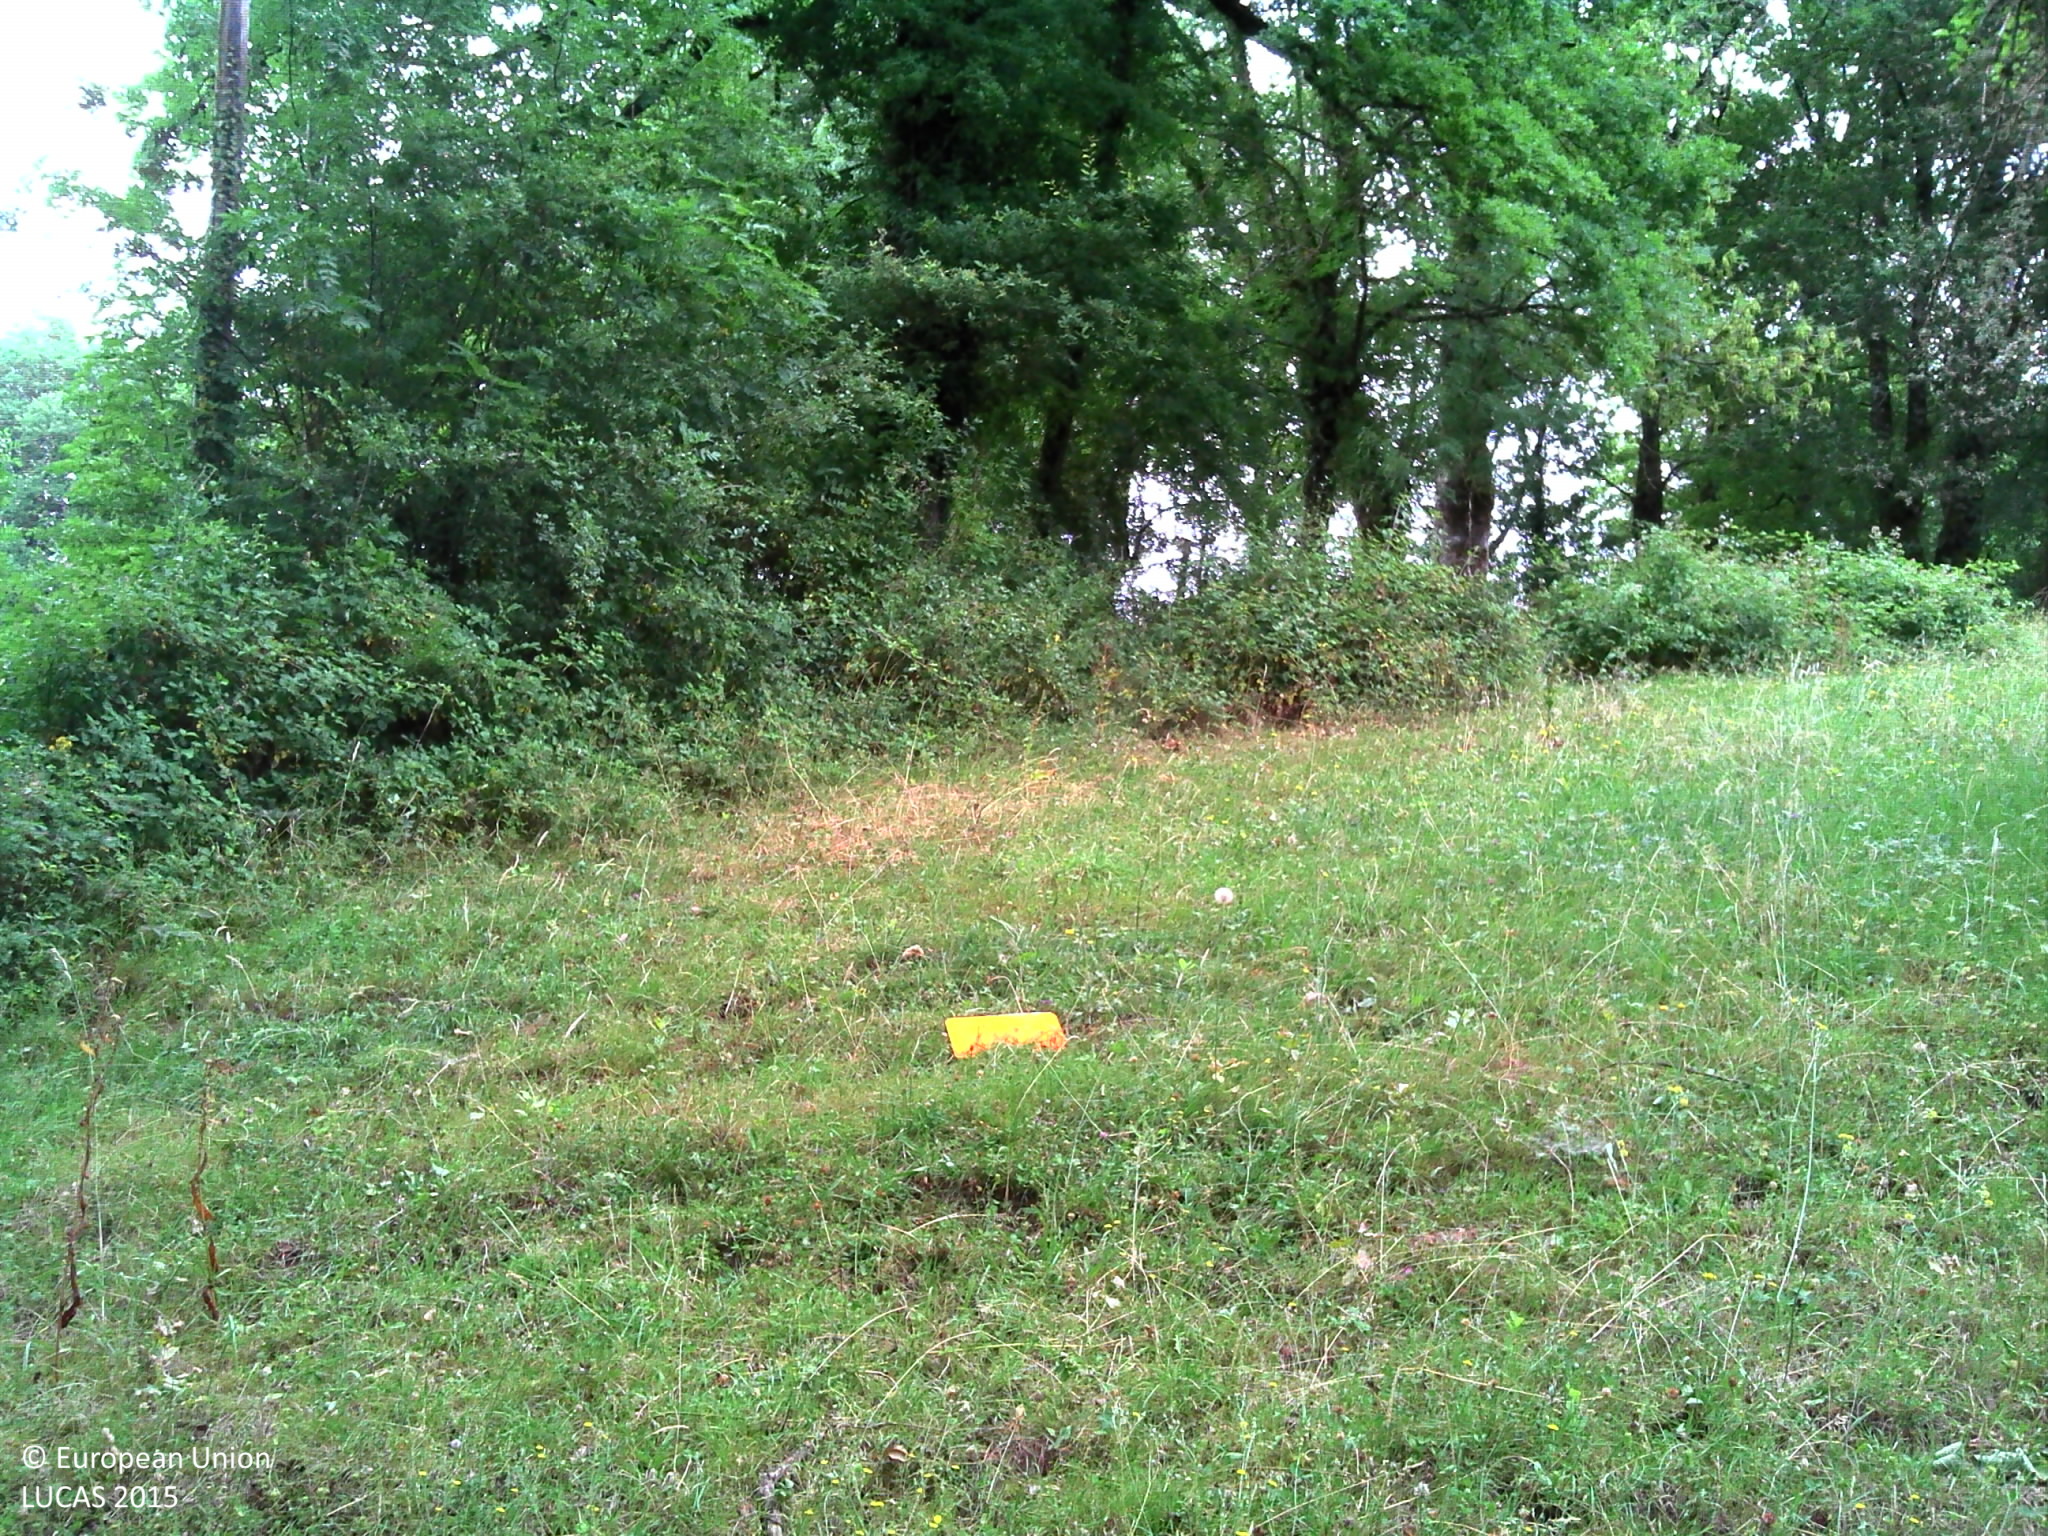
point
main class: Woodland
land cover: Broadleaved woodland
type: mesophytic deciduous forest
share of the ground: > 75 %
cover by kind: broadleaved forest trees 85 %, shrubs 10 %, lichens and mosses 5 %
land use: Forestry
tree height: > 5 m
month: July
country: FR
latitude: 44.4436
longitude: 3.0561
